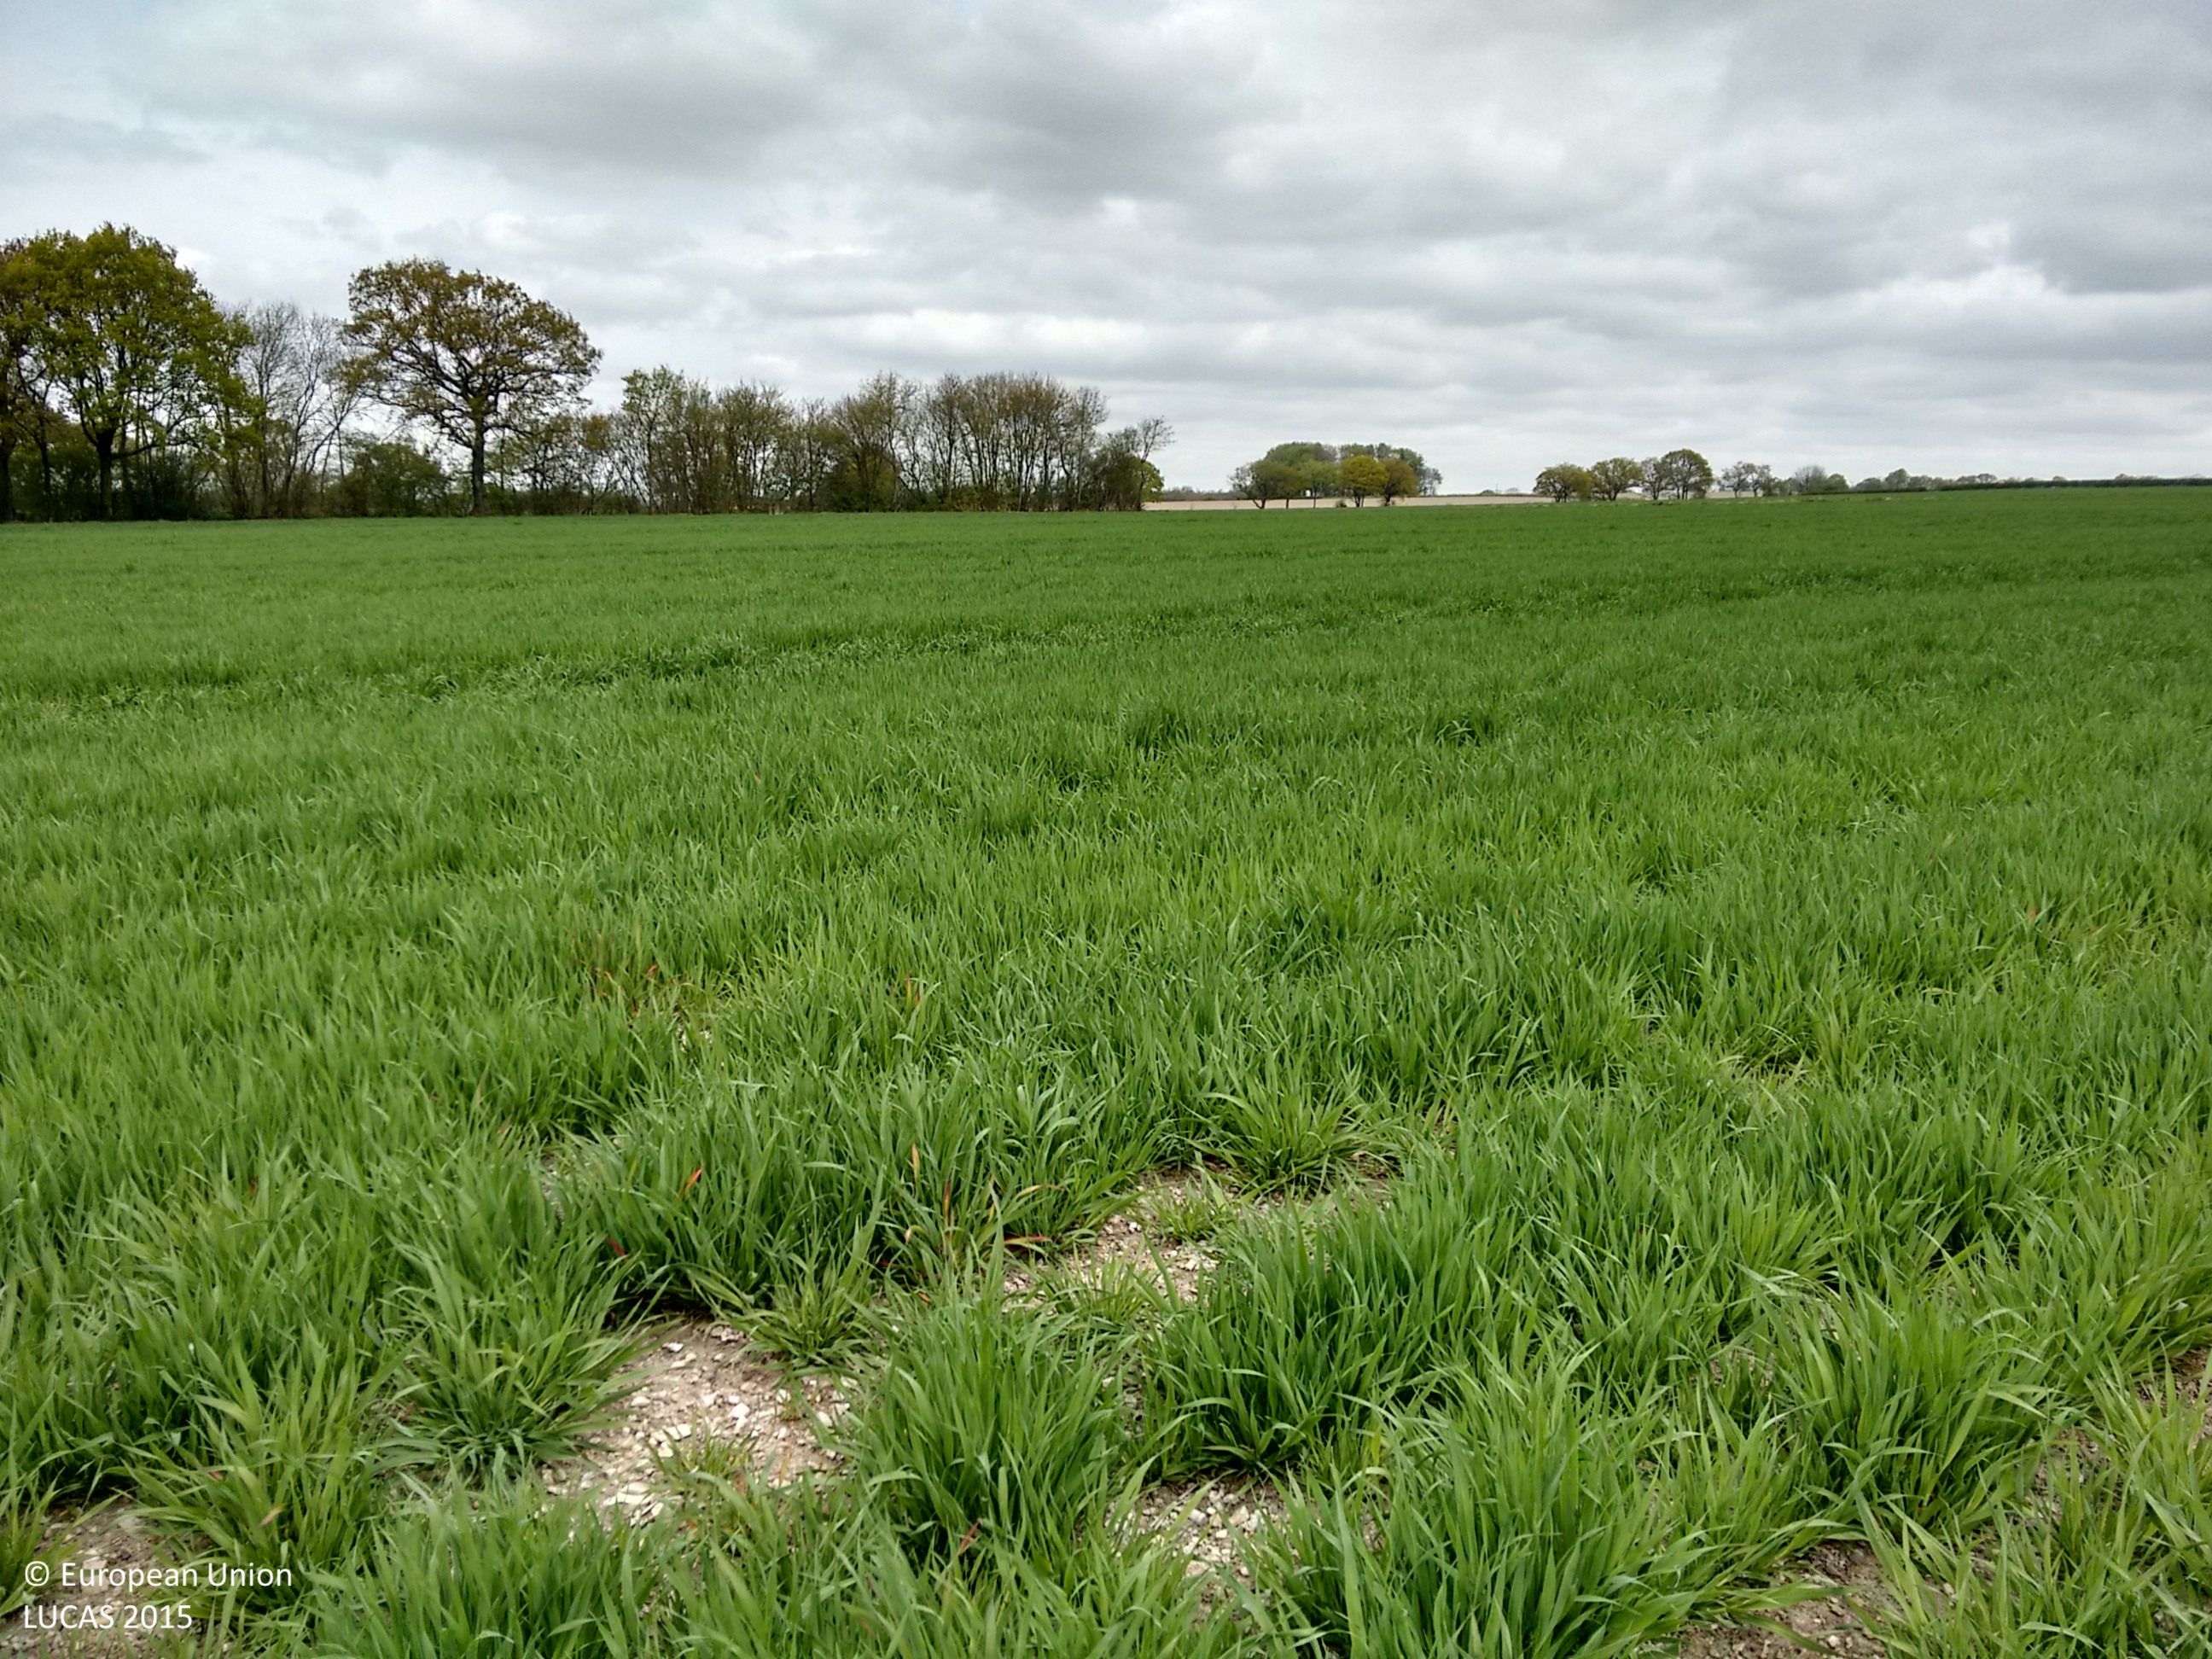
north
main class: Cropland
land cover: Oats
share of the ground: > 75 %
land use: Agriculture (excluding fallow land and kitchen gardens)
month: May
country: GB
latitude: 51.1078
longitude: -0.9416
